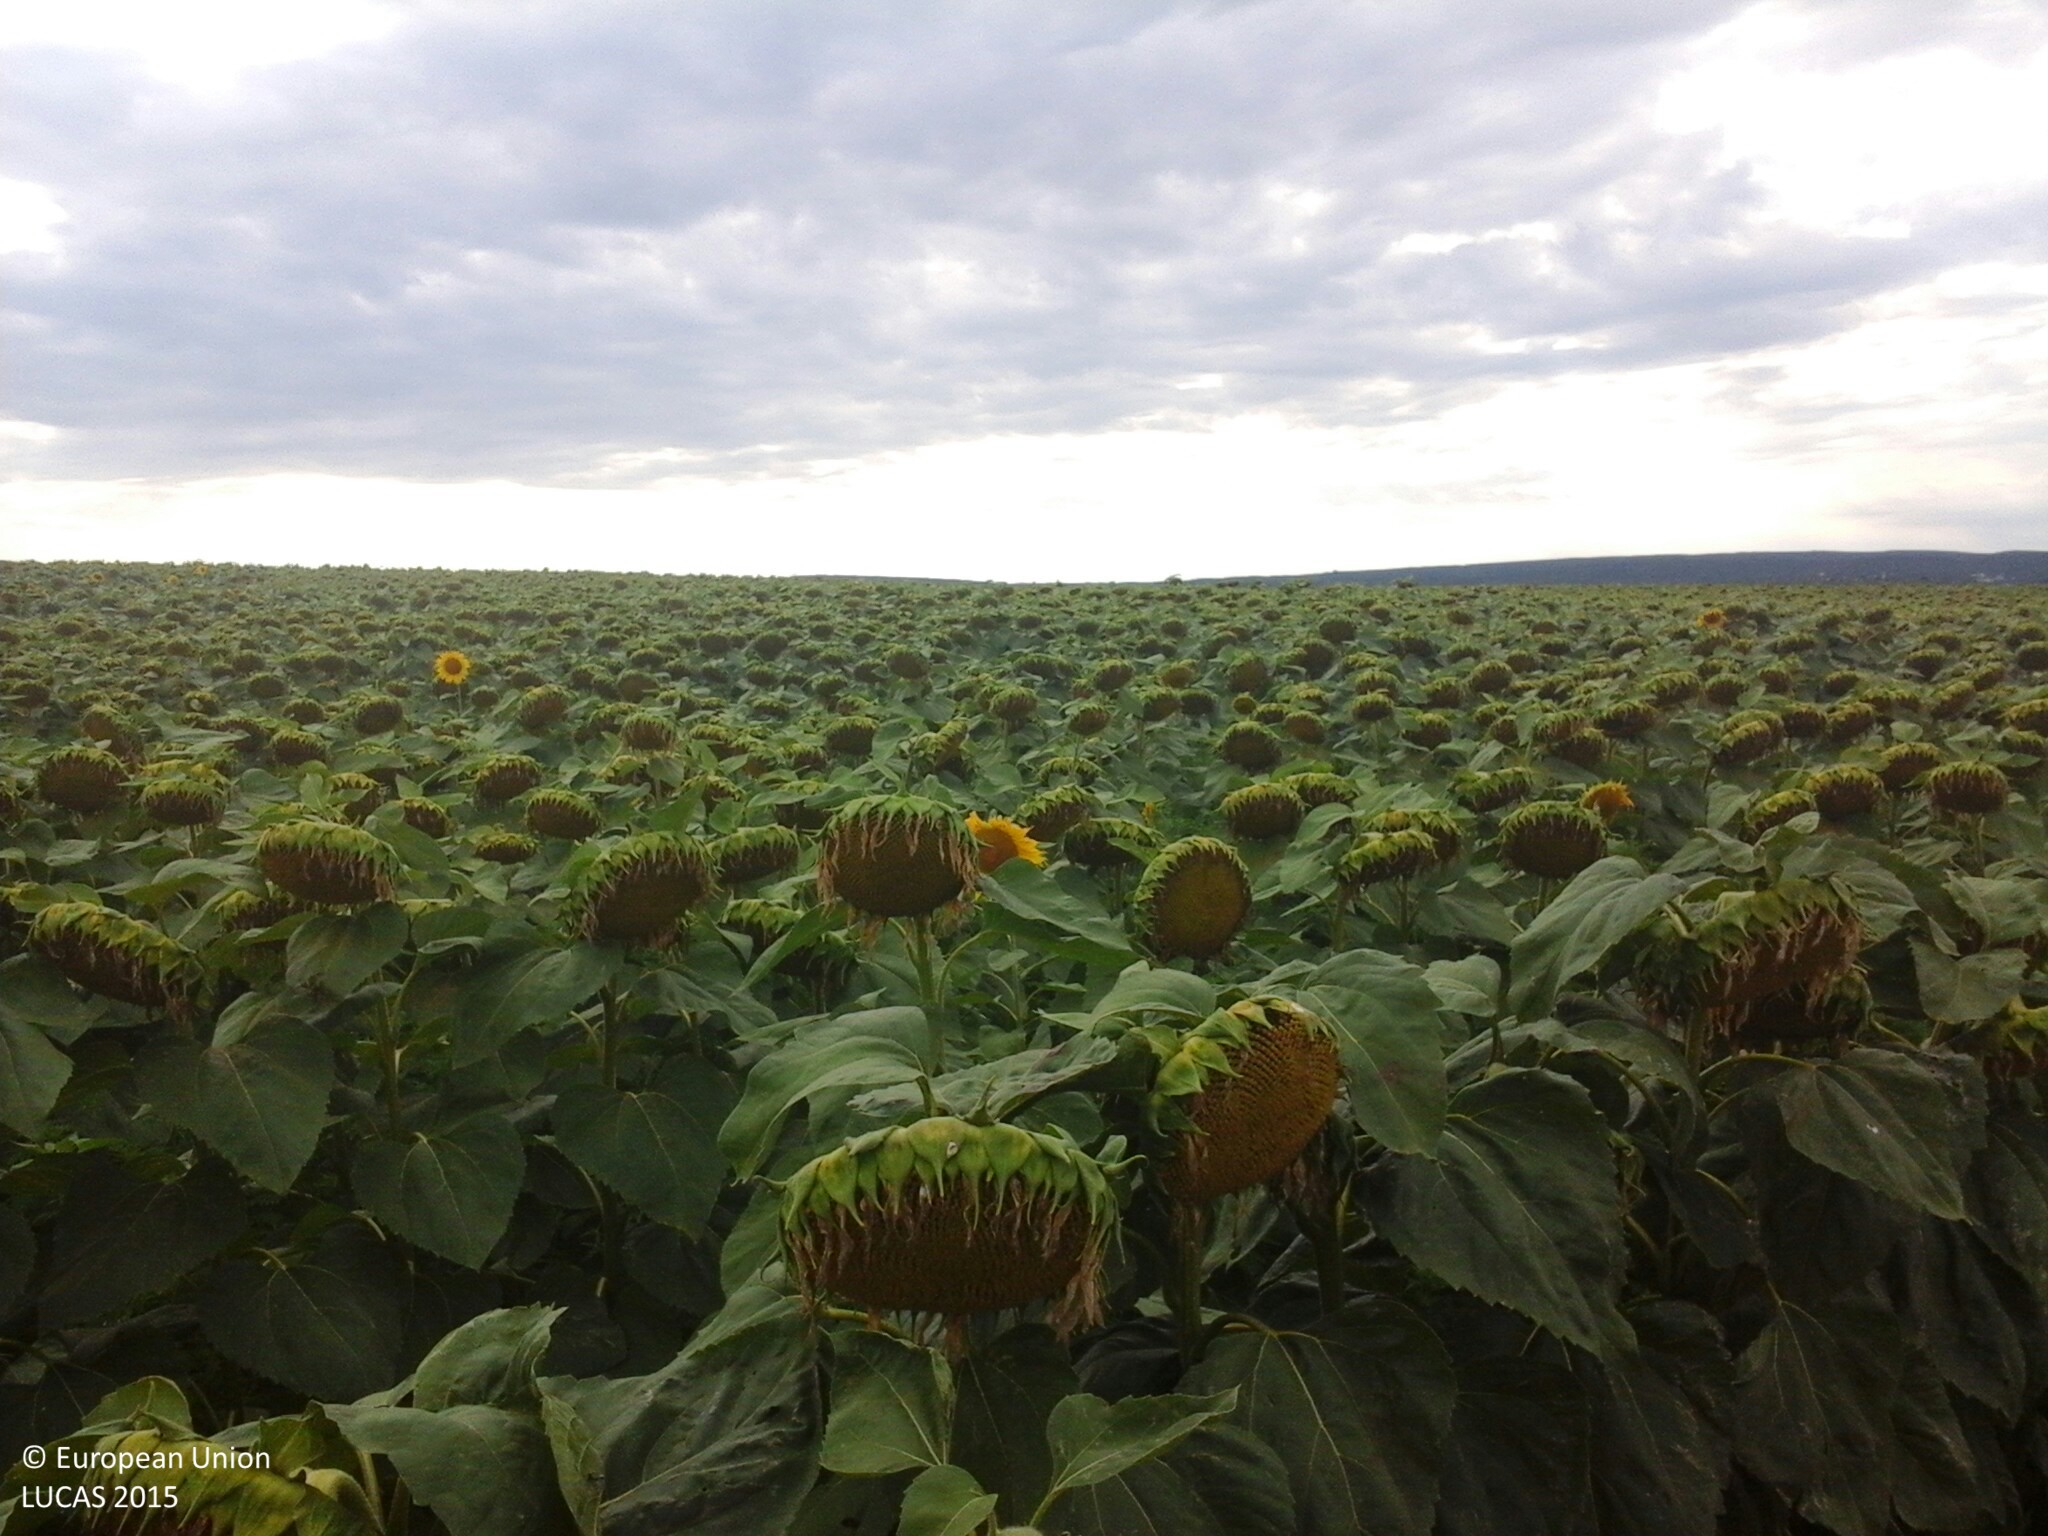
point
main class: Cropland
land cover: Sunflower
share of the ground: > 75 %
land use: Agriculture (excluding fallow land and kitchen gardens)
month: July
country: HU
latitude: 47.0585
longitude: 18.0802
